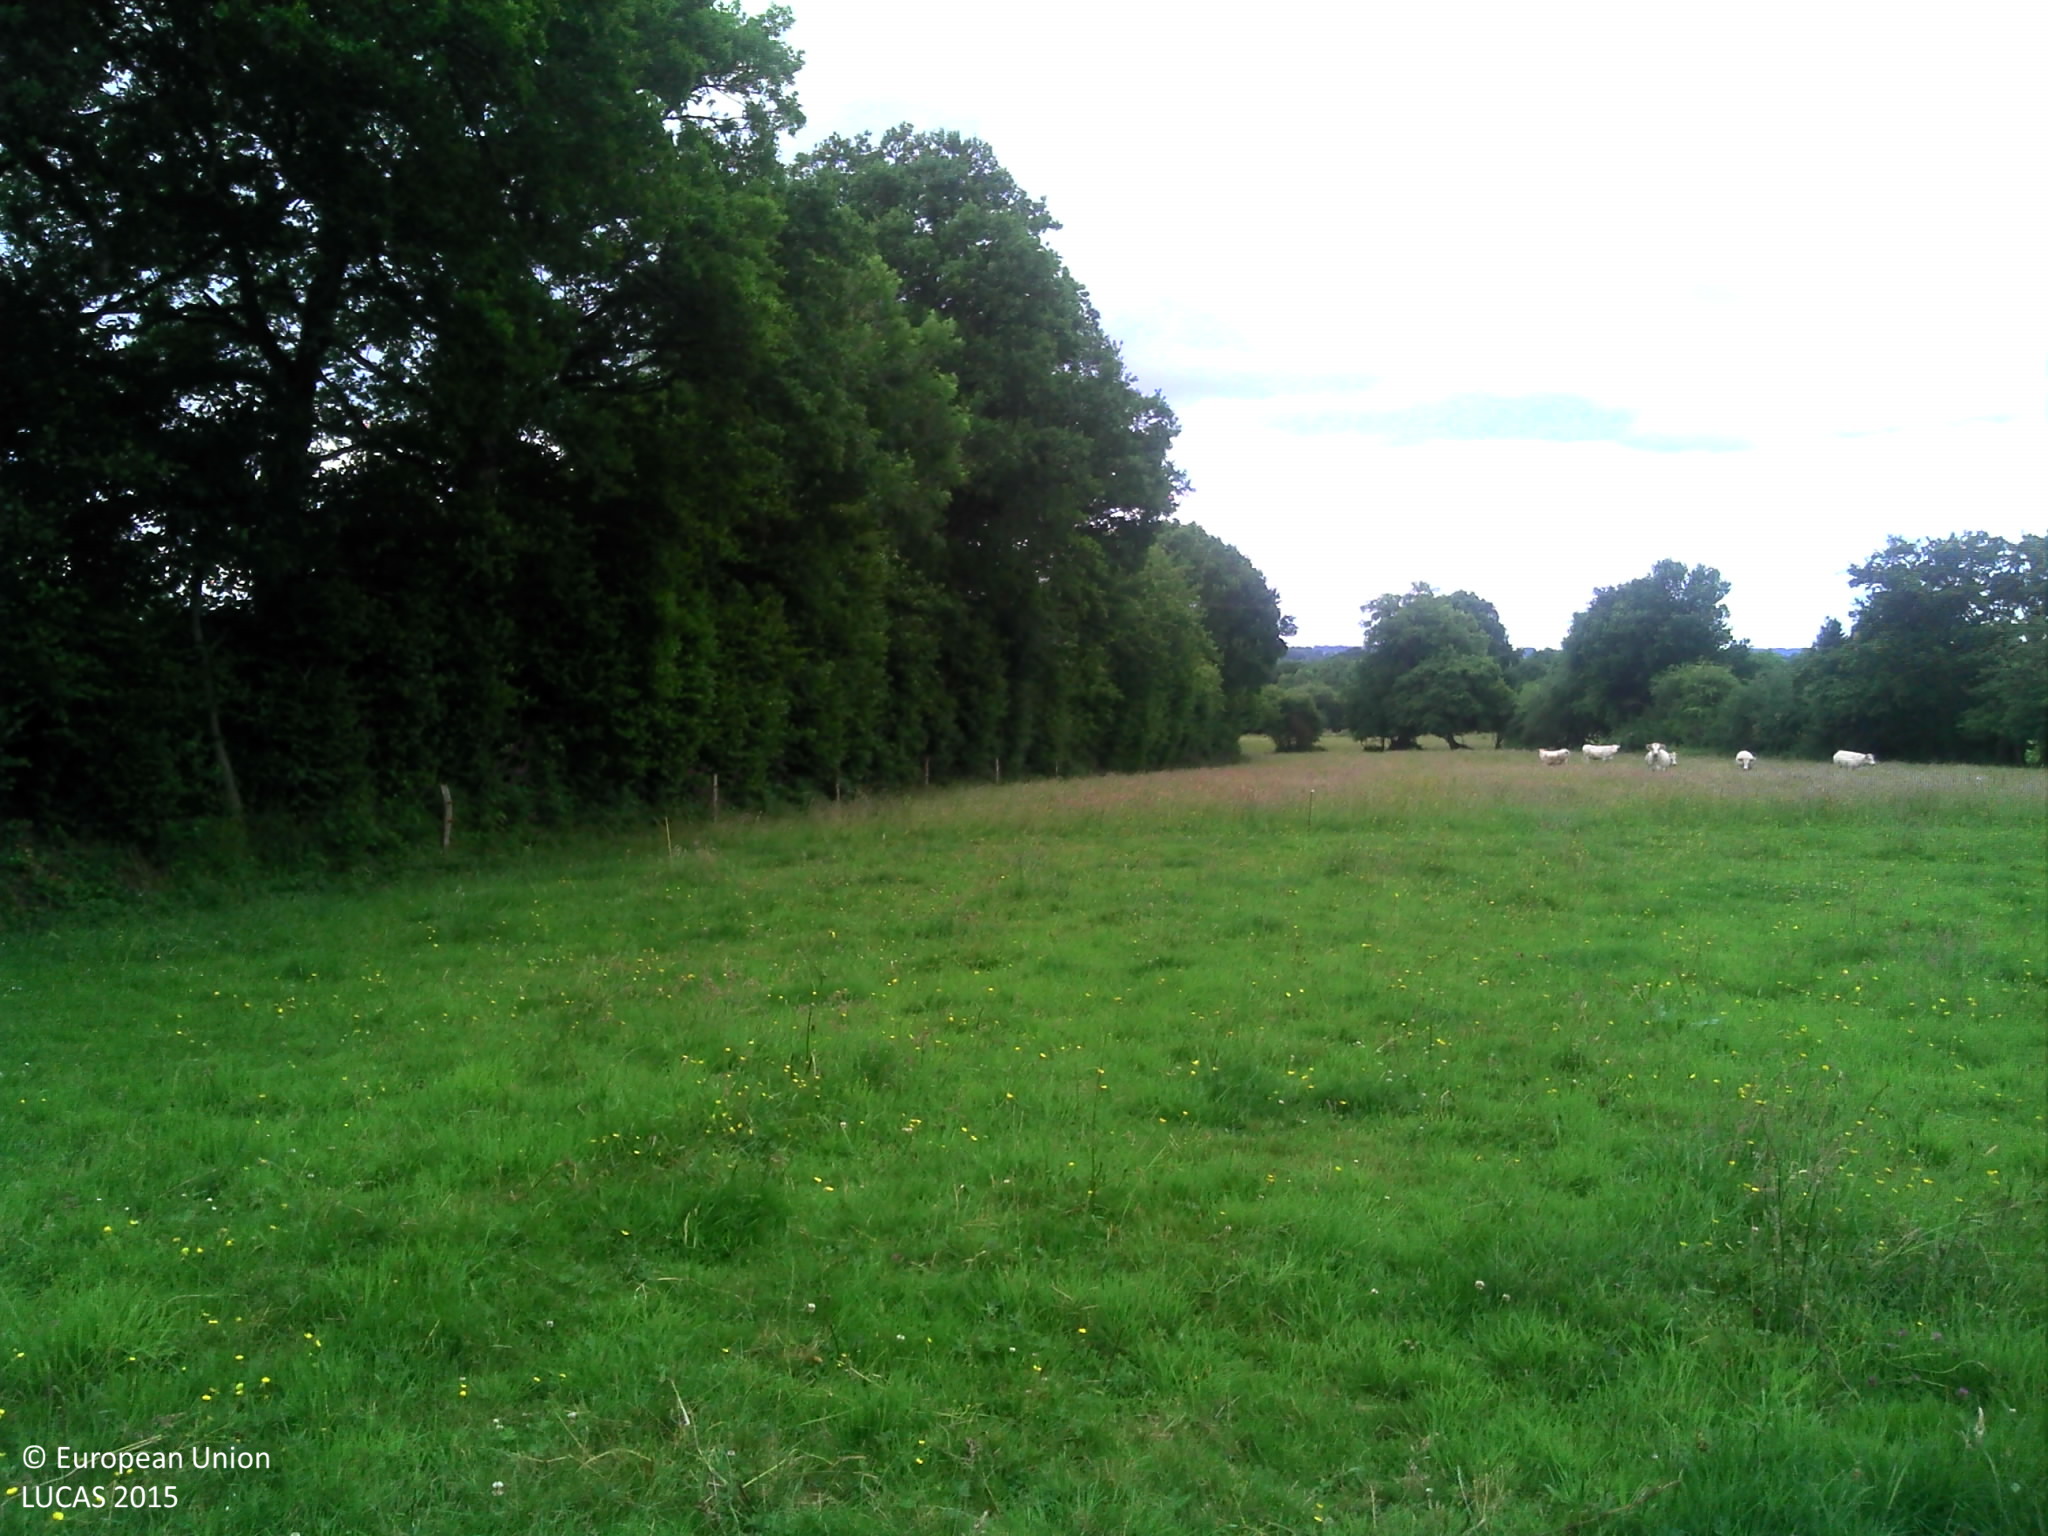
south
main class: Grassland
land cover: Grassland without tree/shrub cover
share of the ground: > 75 %
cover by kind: herbaceous plants 100 %
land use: Agriculture (excluding fallow land and kitchen gardens)
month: June
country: FR
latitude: 48.6712
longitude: -0.2306
